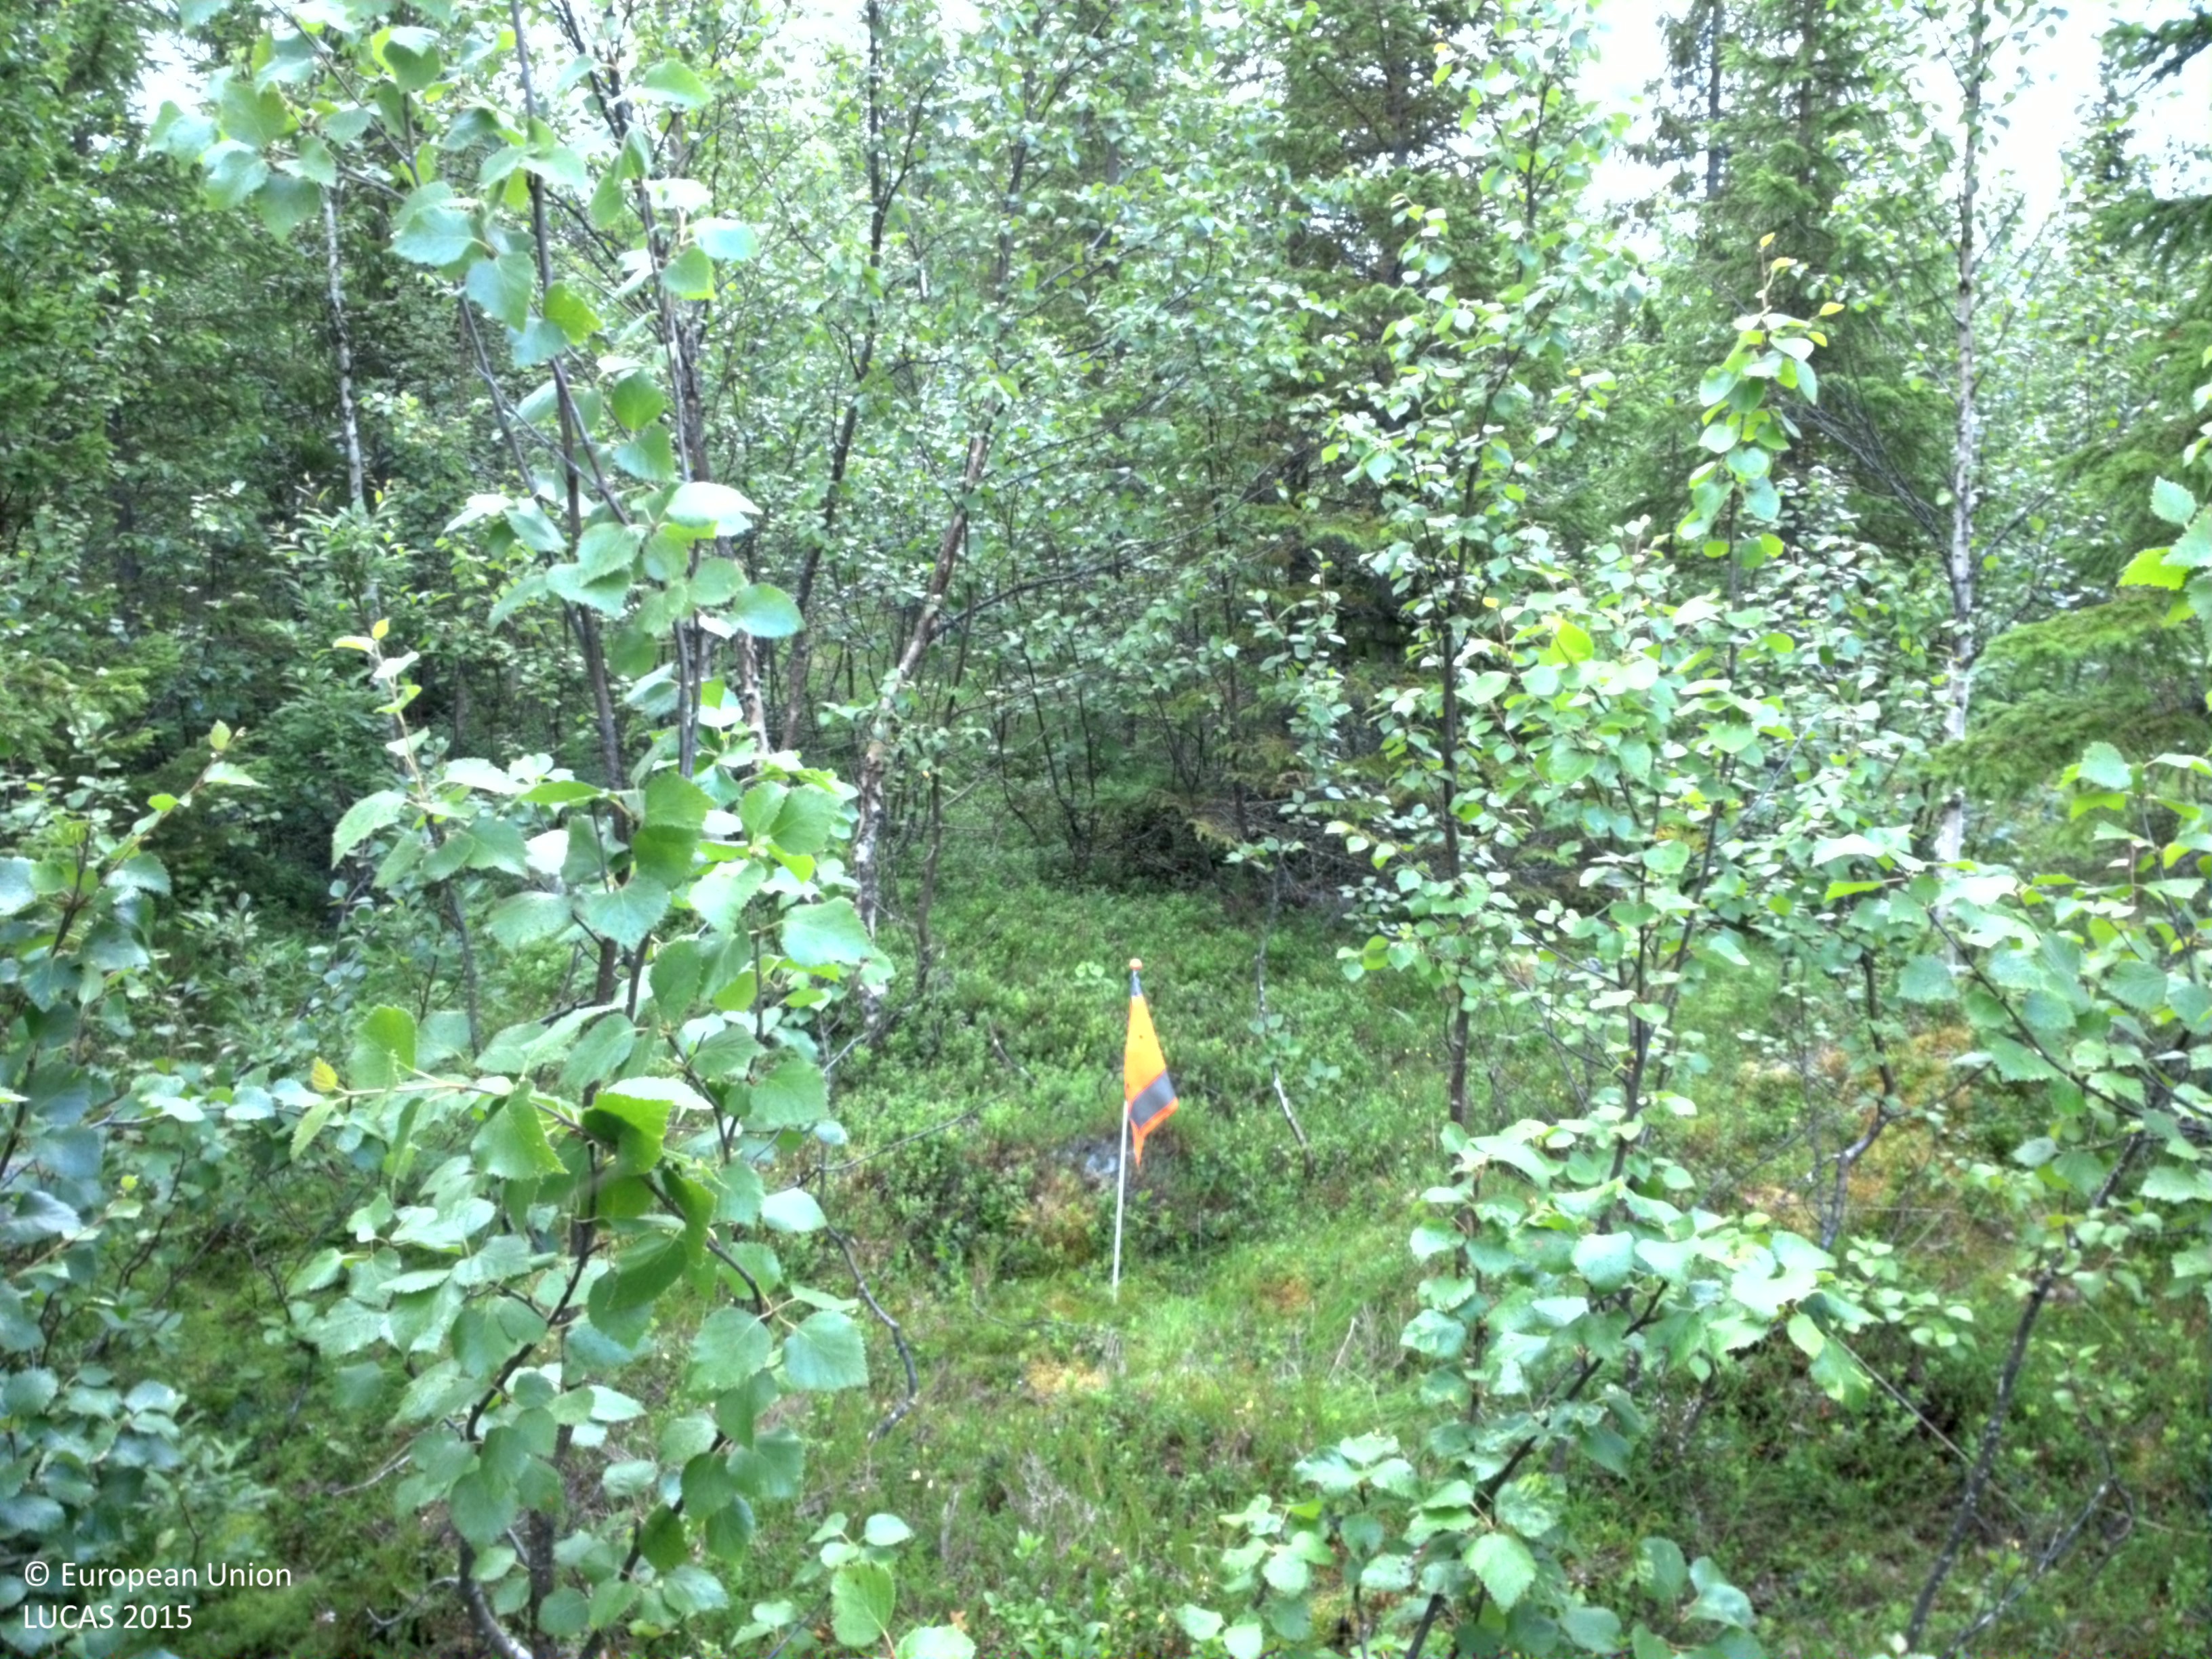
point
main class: Woodland
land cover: Spruce dominated mixed woodland
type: boreal forest
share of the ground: 25 - 50 %
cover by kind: shrubs 40 %, broadleaved forest trees 25 %, coniferous forest trees 15 %, lichens and mosses 15 %, herbaceous plants 5 %
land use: Forestry
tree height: > 5 m
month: August
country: SE
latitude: 64.8377
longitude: 16.2267
